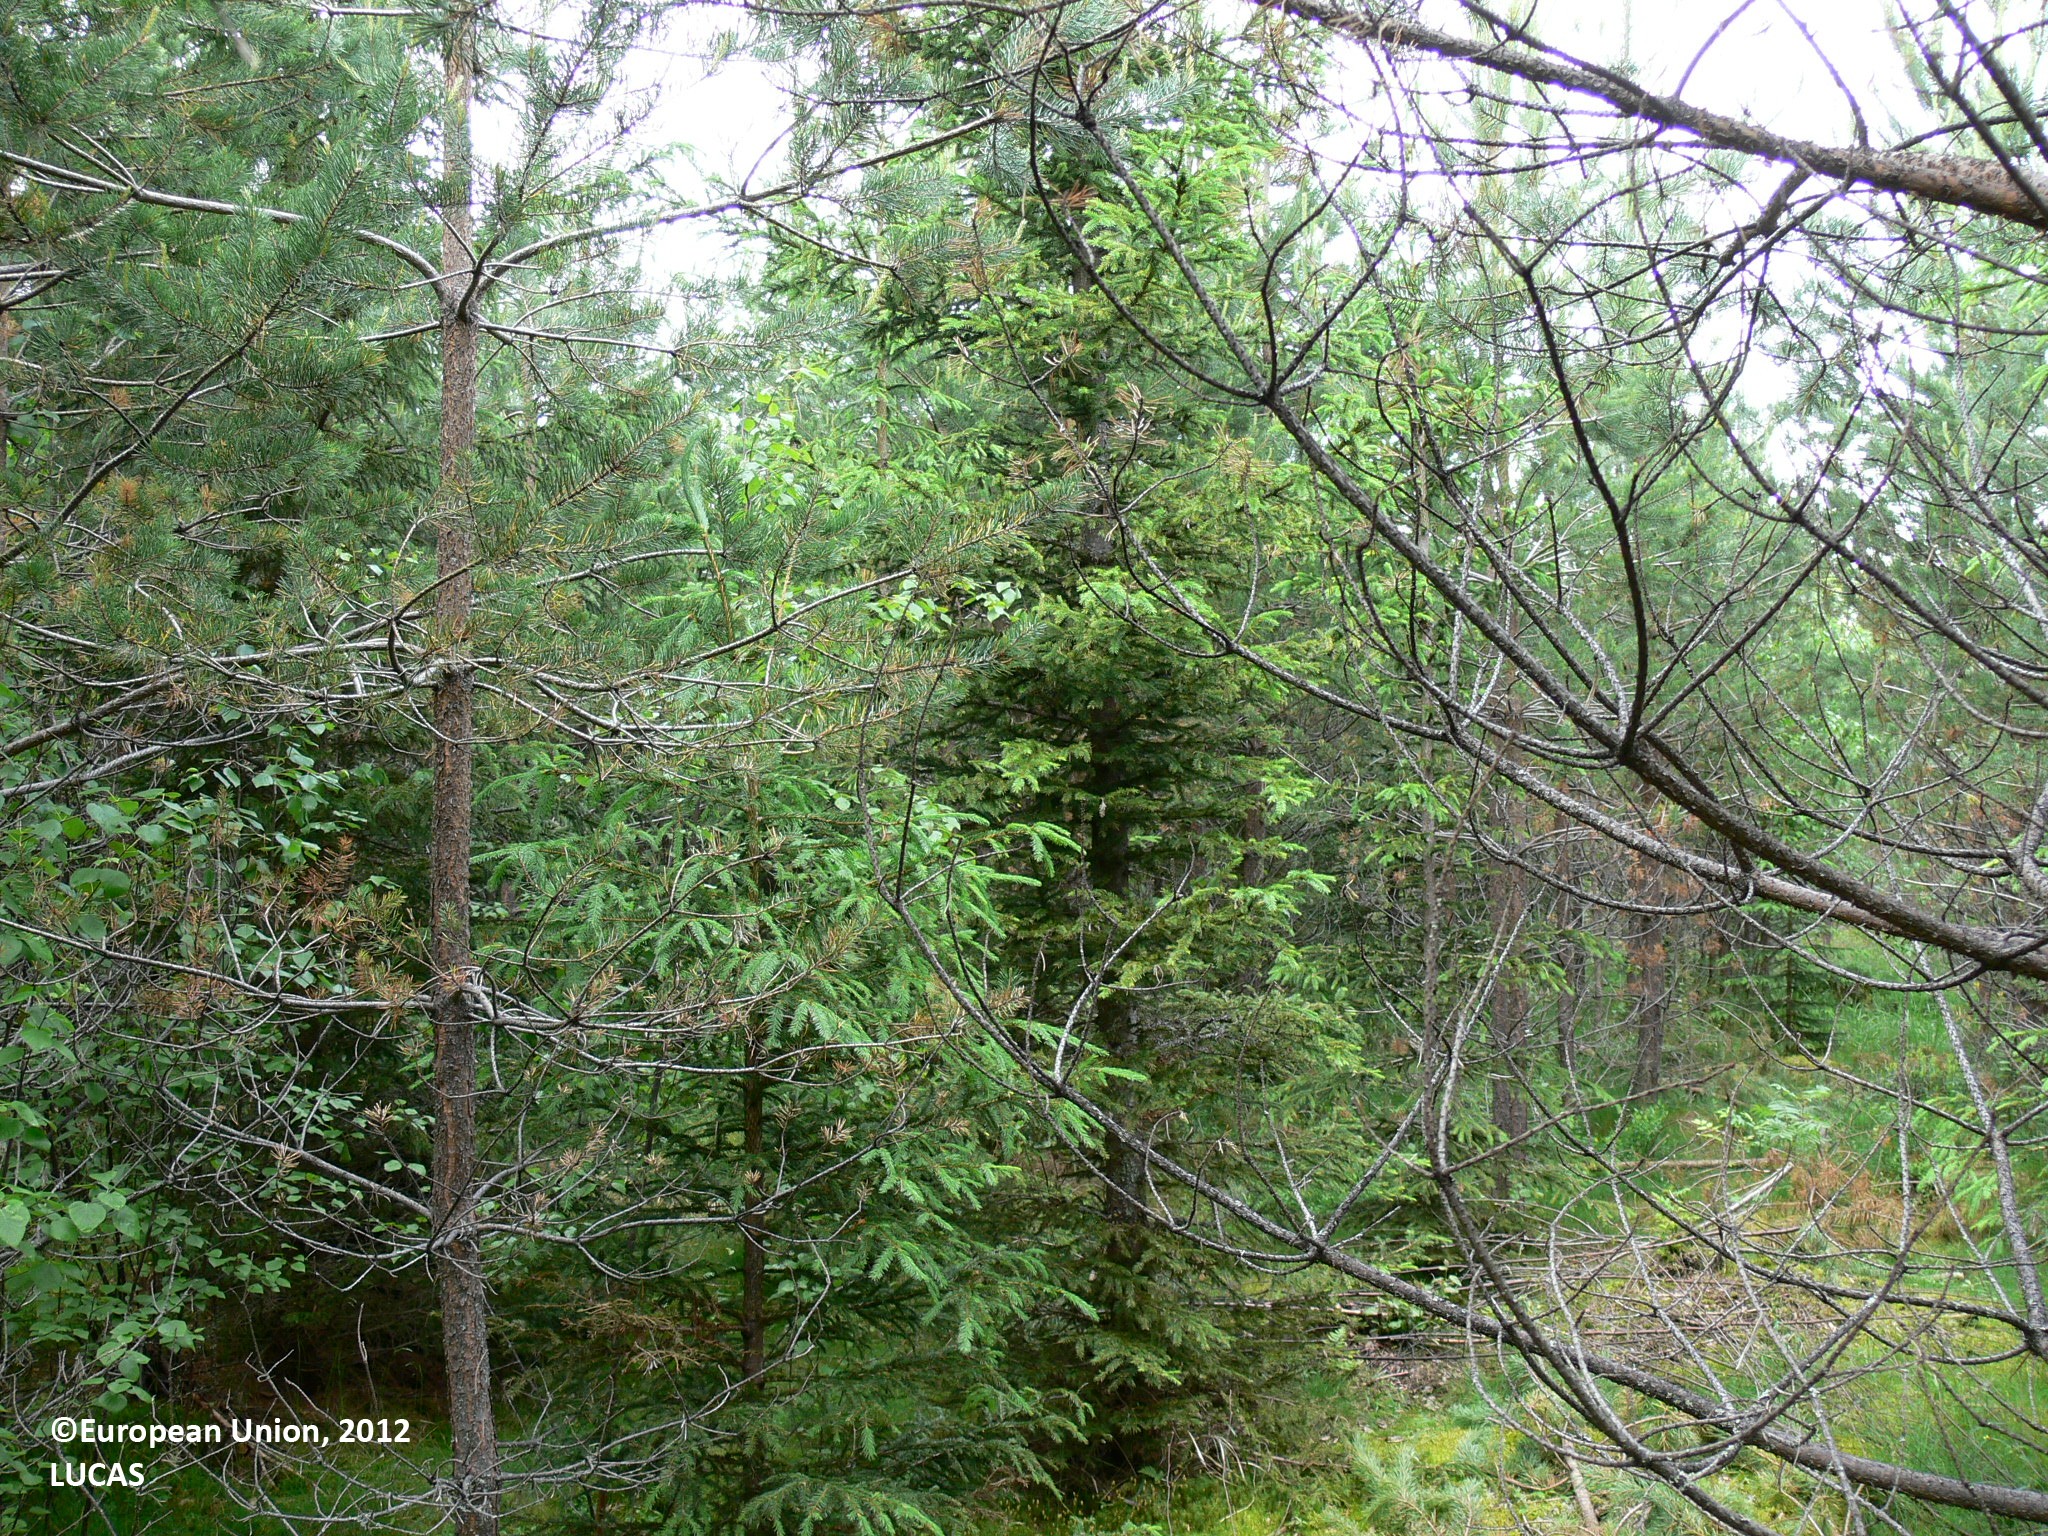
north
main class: Woodland
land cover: Other coniferous woodland
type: boreal forest
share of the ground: > 75 %
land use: Forestry
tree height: < 5 m
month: June
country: FI
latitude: 62.5486
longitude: 29.5085
